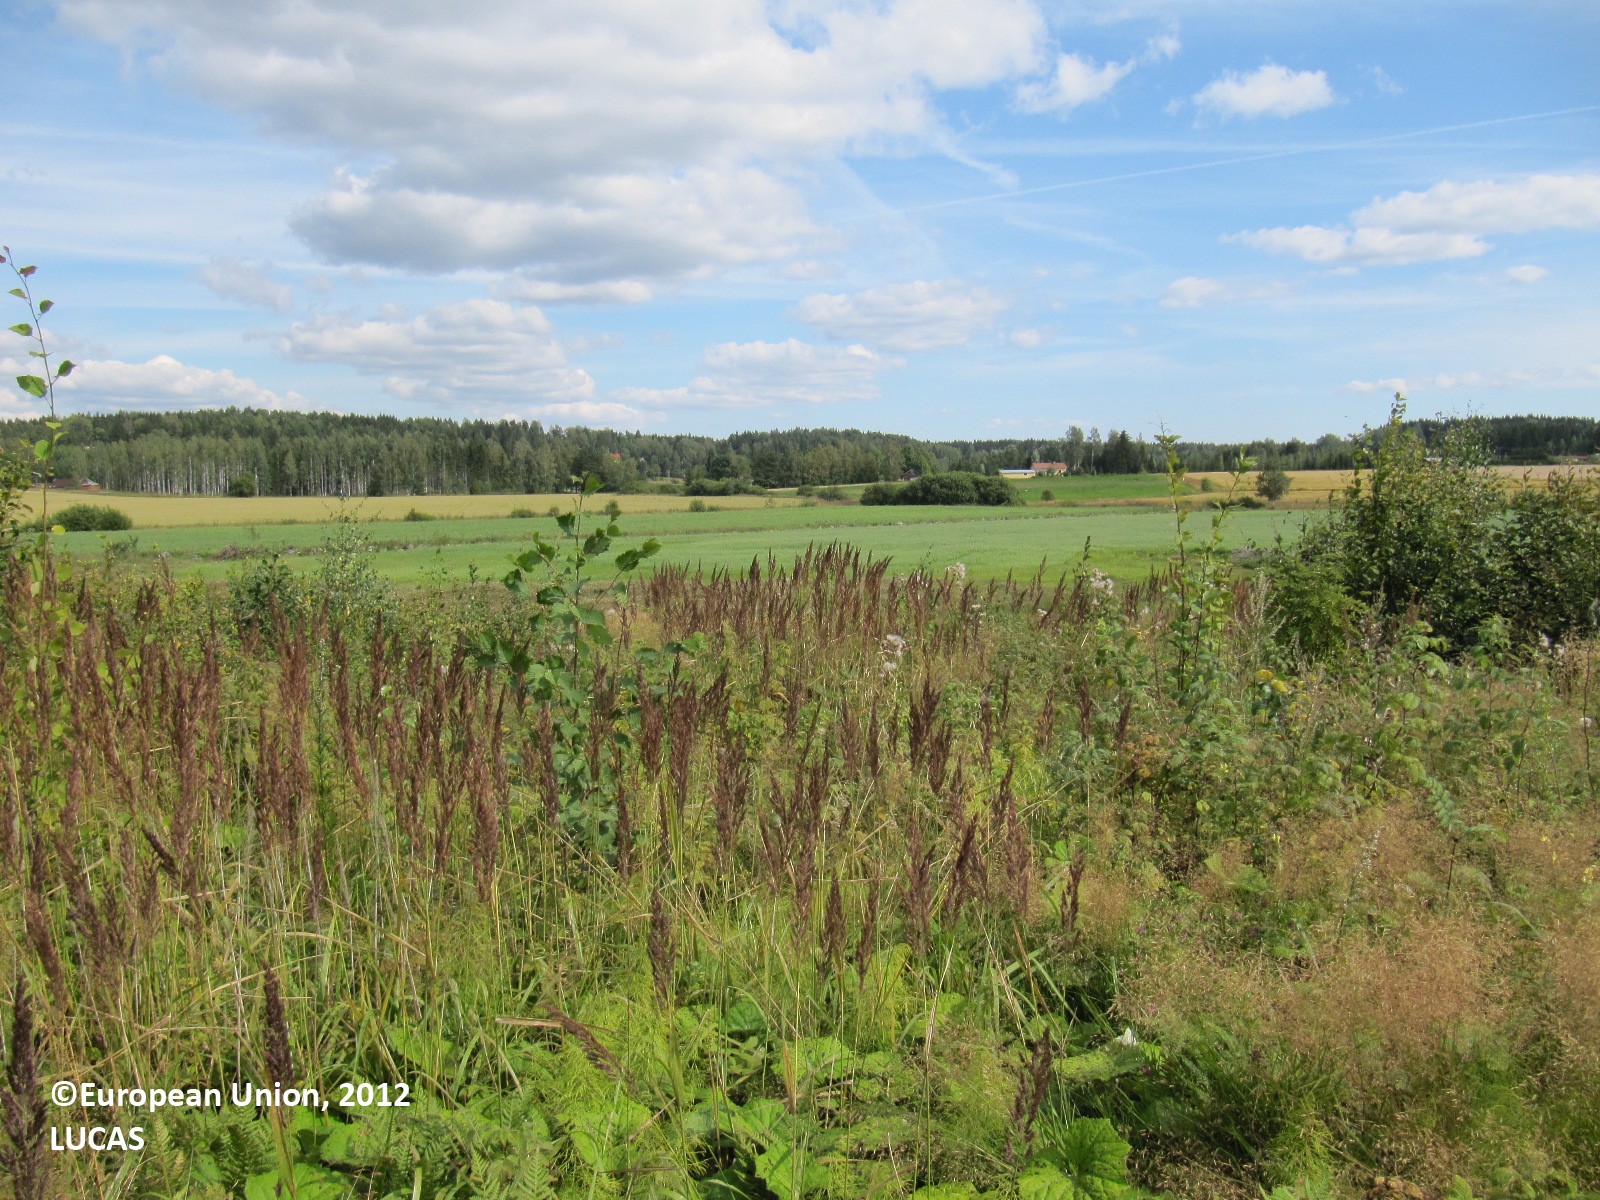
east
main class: Grassland
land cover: Grassland with sparse tree/shrub cover
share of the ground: > 75 %
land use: Semi-natural and natural areas not in use
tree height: < 5 m
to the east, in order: Grassland with sparse tree/shrub cover; Spontaneously vegetated surfaces; Oats; Shruby margins; Ditches and canals; Shruby margins; Oats; Grass margins; Ditches and canals; Shruby margins; Common wheat
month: August
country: FI
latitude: 60.3815
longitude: 24.3063
